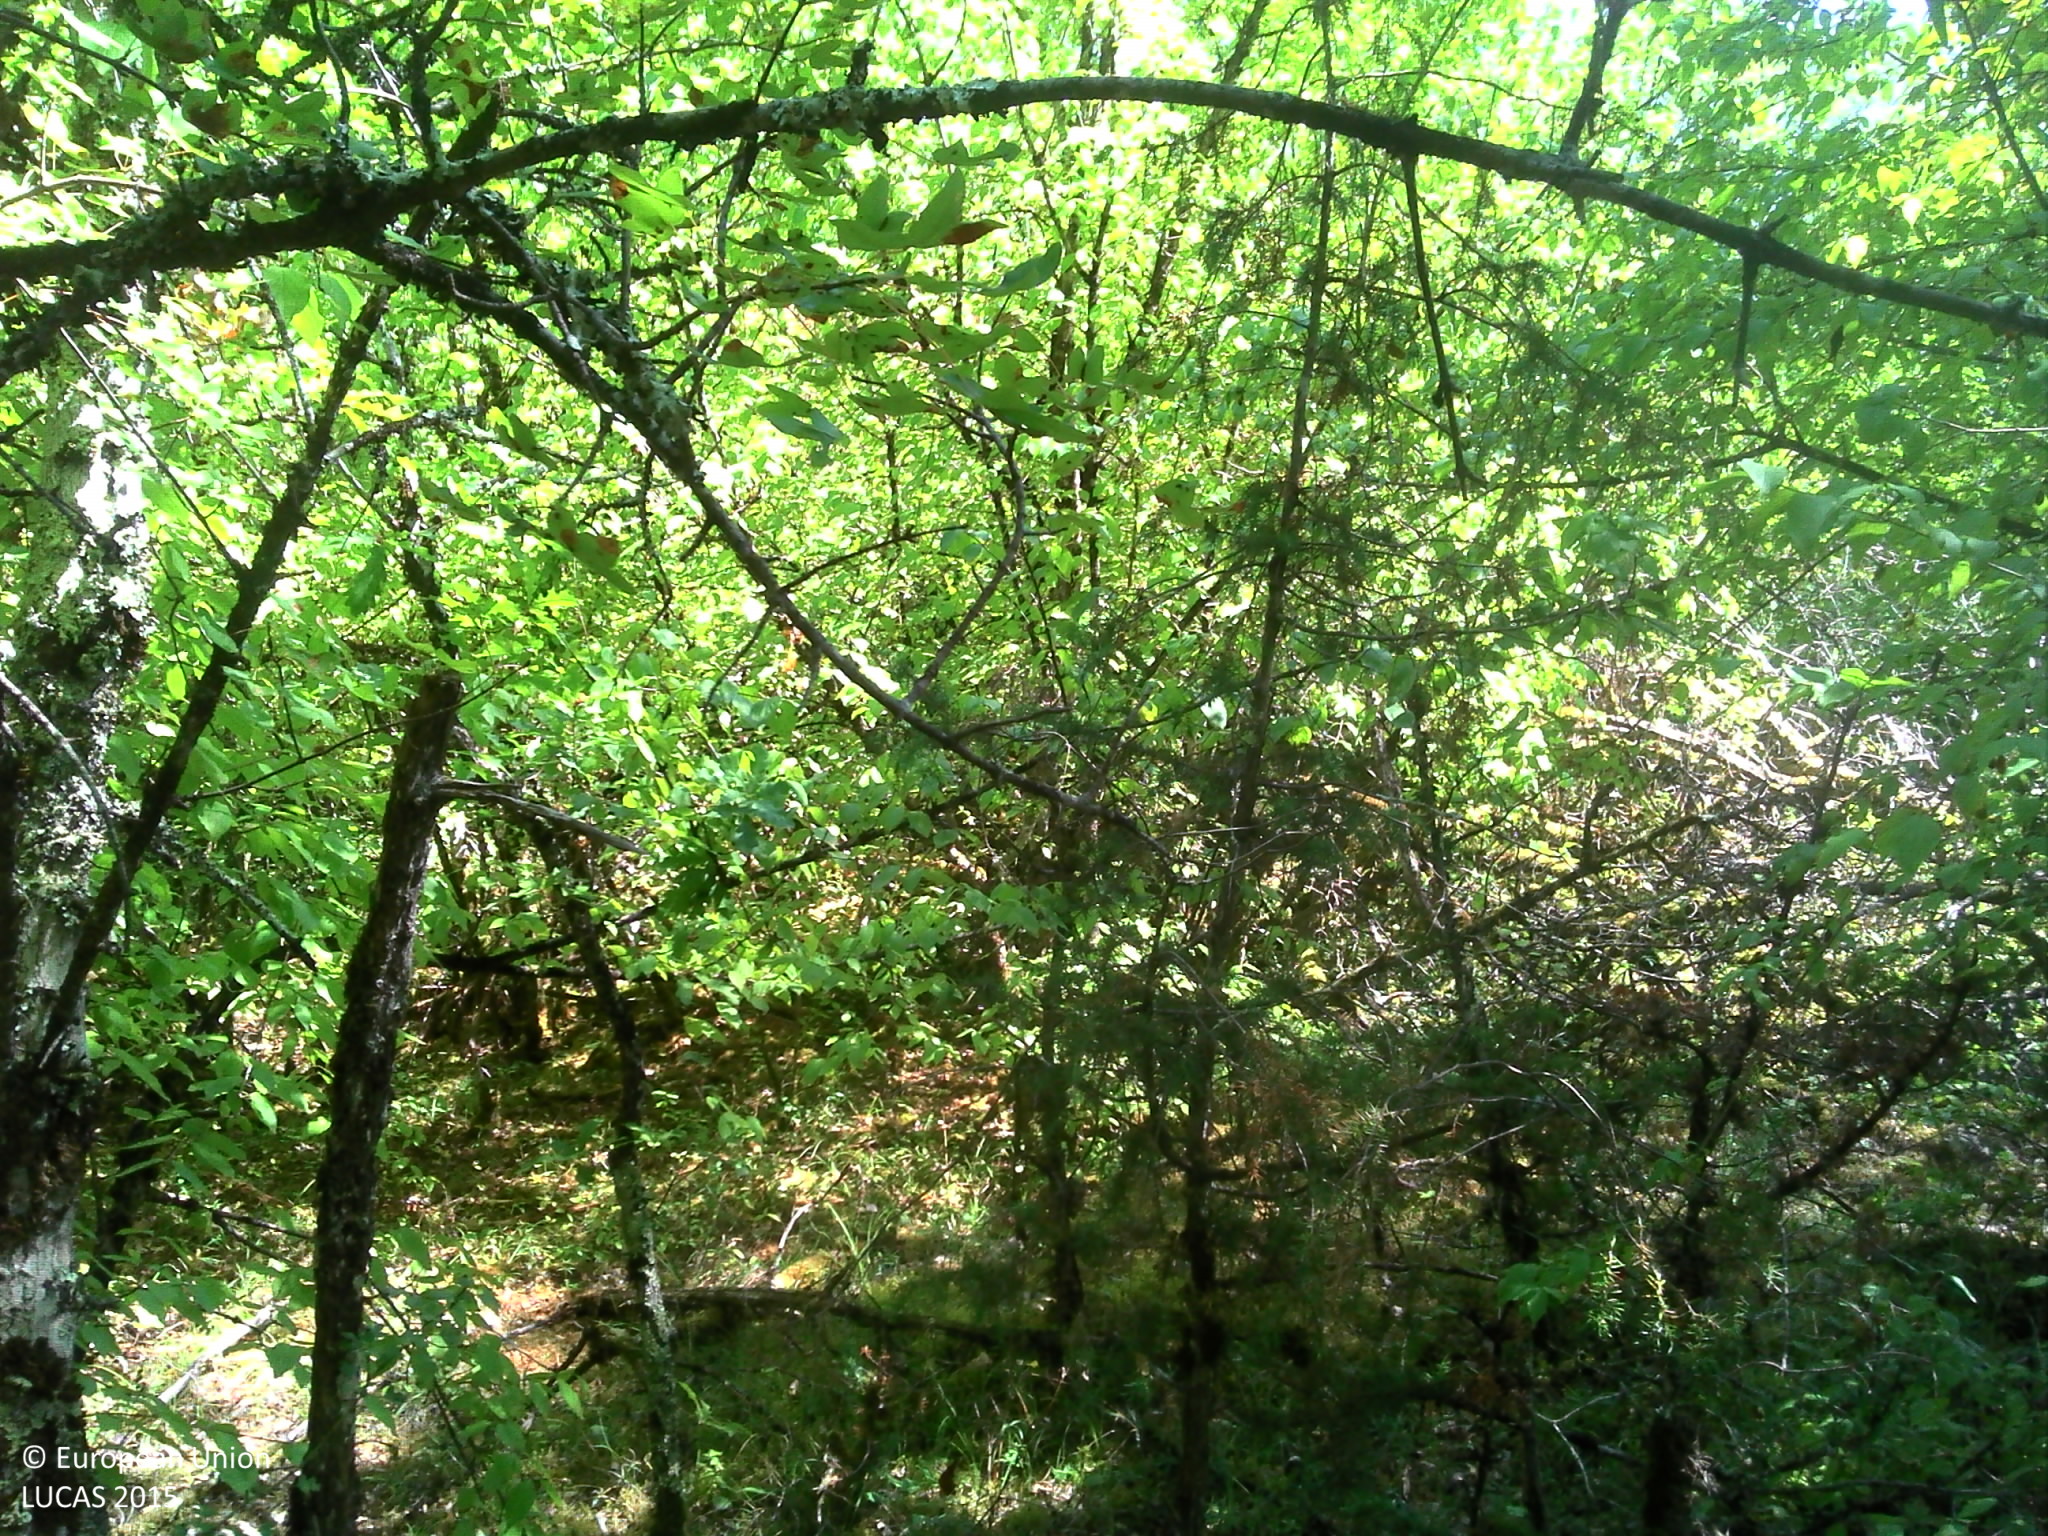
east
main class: Woodland
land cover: Broadleaved woodland
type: mesophytic deciduous forest
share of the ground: > 75 %
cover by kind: broadleaved forest trees 60 %, shrubs 30 %, herbaceous plants 10 %
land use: Forestry
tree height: > 5 m
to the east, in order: Broadleaved woodland; Grassland with sparse tree/shrub cover; Dry stone walls; Fences; Grassland with sparse tree/shrub cover; Dry stone walls; Grassland with sparse tree/shrub cover; Lines of trees; Dry stone walls; Broadleaved woodland; Fences; Dry stone walls; Grass margins; Tracks; Grass margins; Dry stone walls; Shrubland with sparse tree cover; Broadleaved woodland
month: August
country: FR
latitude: 44.7306
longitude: 1.7784
